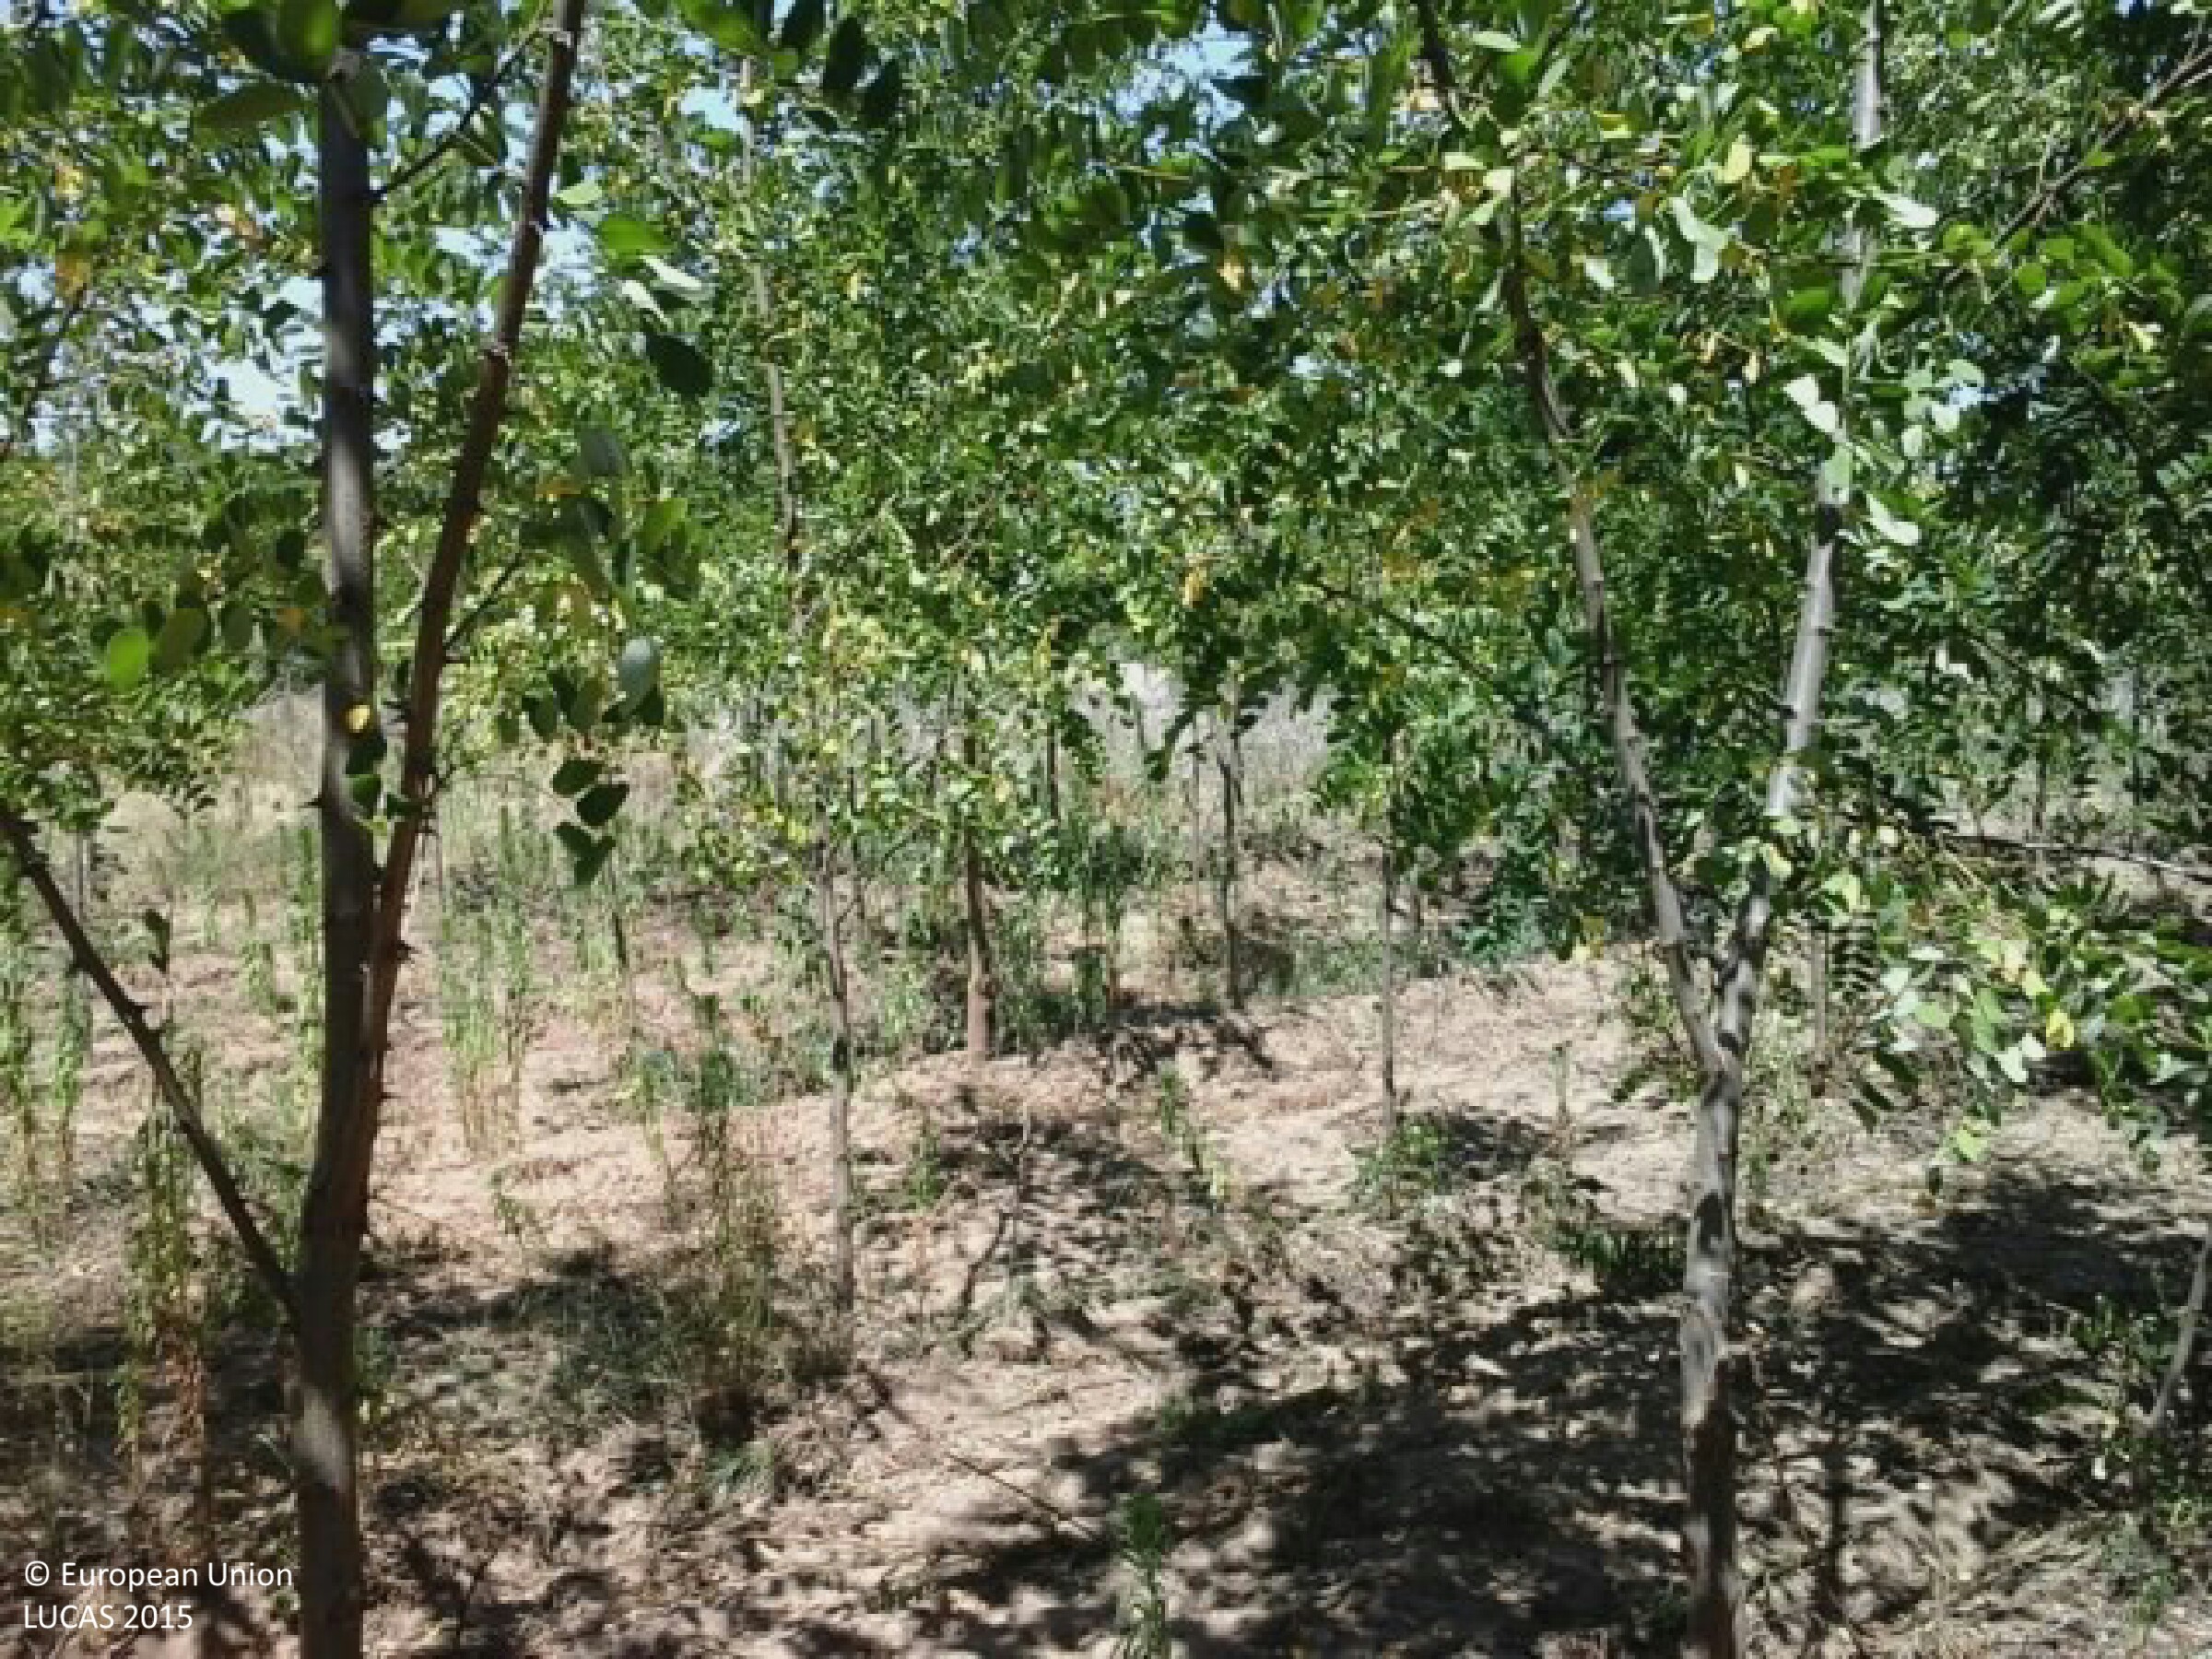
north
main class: Woodland
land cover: Broadleaved woodland
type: exotic forest
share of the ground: 50 - 75 %
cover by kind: broadleaved forest trees 70 %, herbaceous plants 15 %, unconsolidated bare surface 15 %
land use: Forestry
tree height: < 5 m
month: July
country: HU
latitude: 47.2896
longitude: 19.2613
